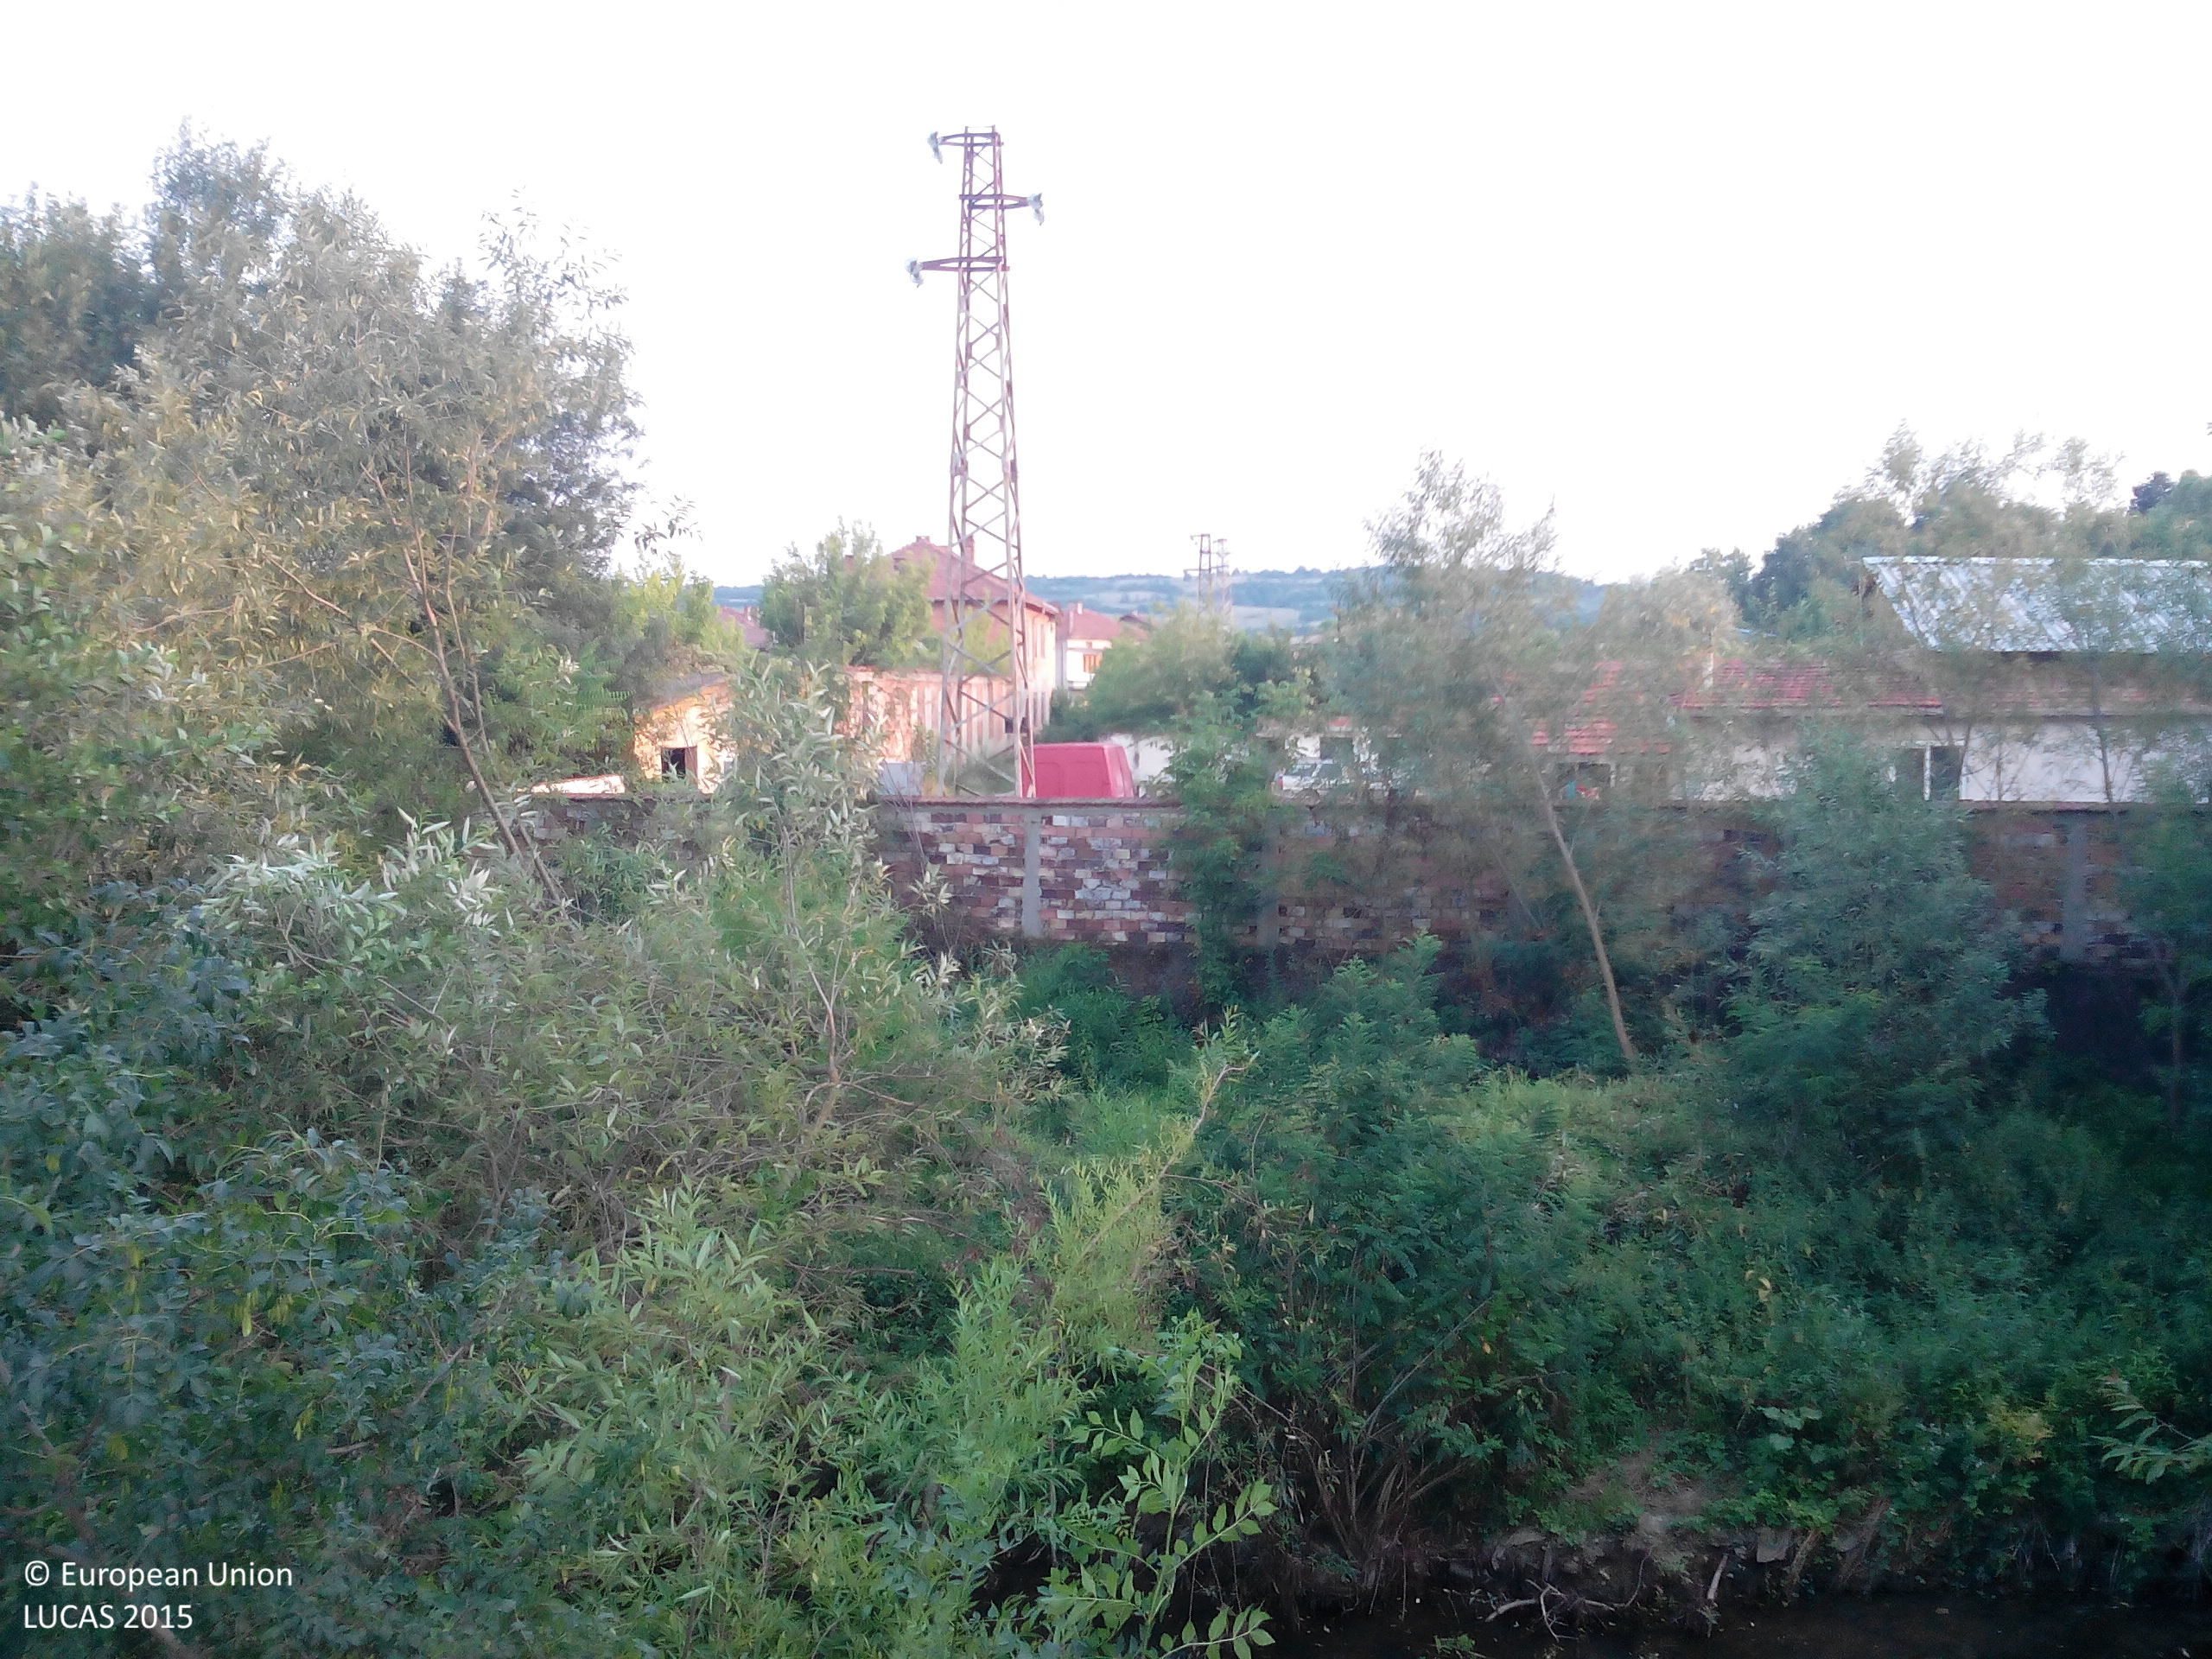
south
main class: Woodland
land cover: Broadleaved woodland
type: mesophytic deciduous forest
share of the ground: 25 - 50 %
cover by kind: broadleaved forest trees 45 %, herbaceous plants 30 %, shrubs 20 %
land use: Amenities, museums, leisure
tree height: > 5 m
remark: Temporary dry
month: July
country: BG
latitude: 43.2077
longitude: 24.1704
